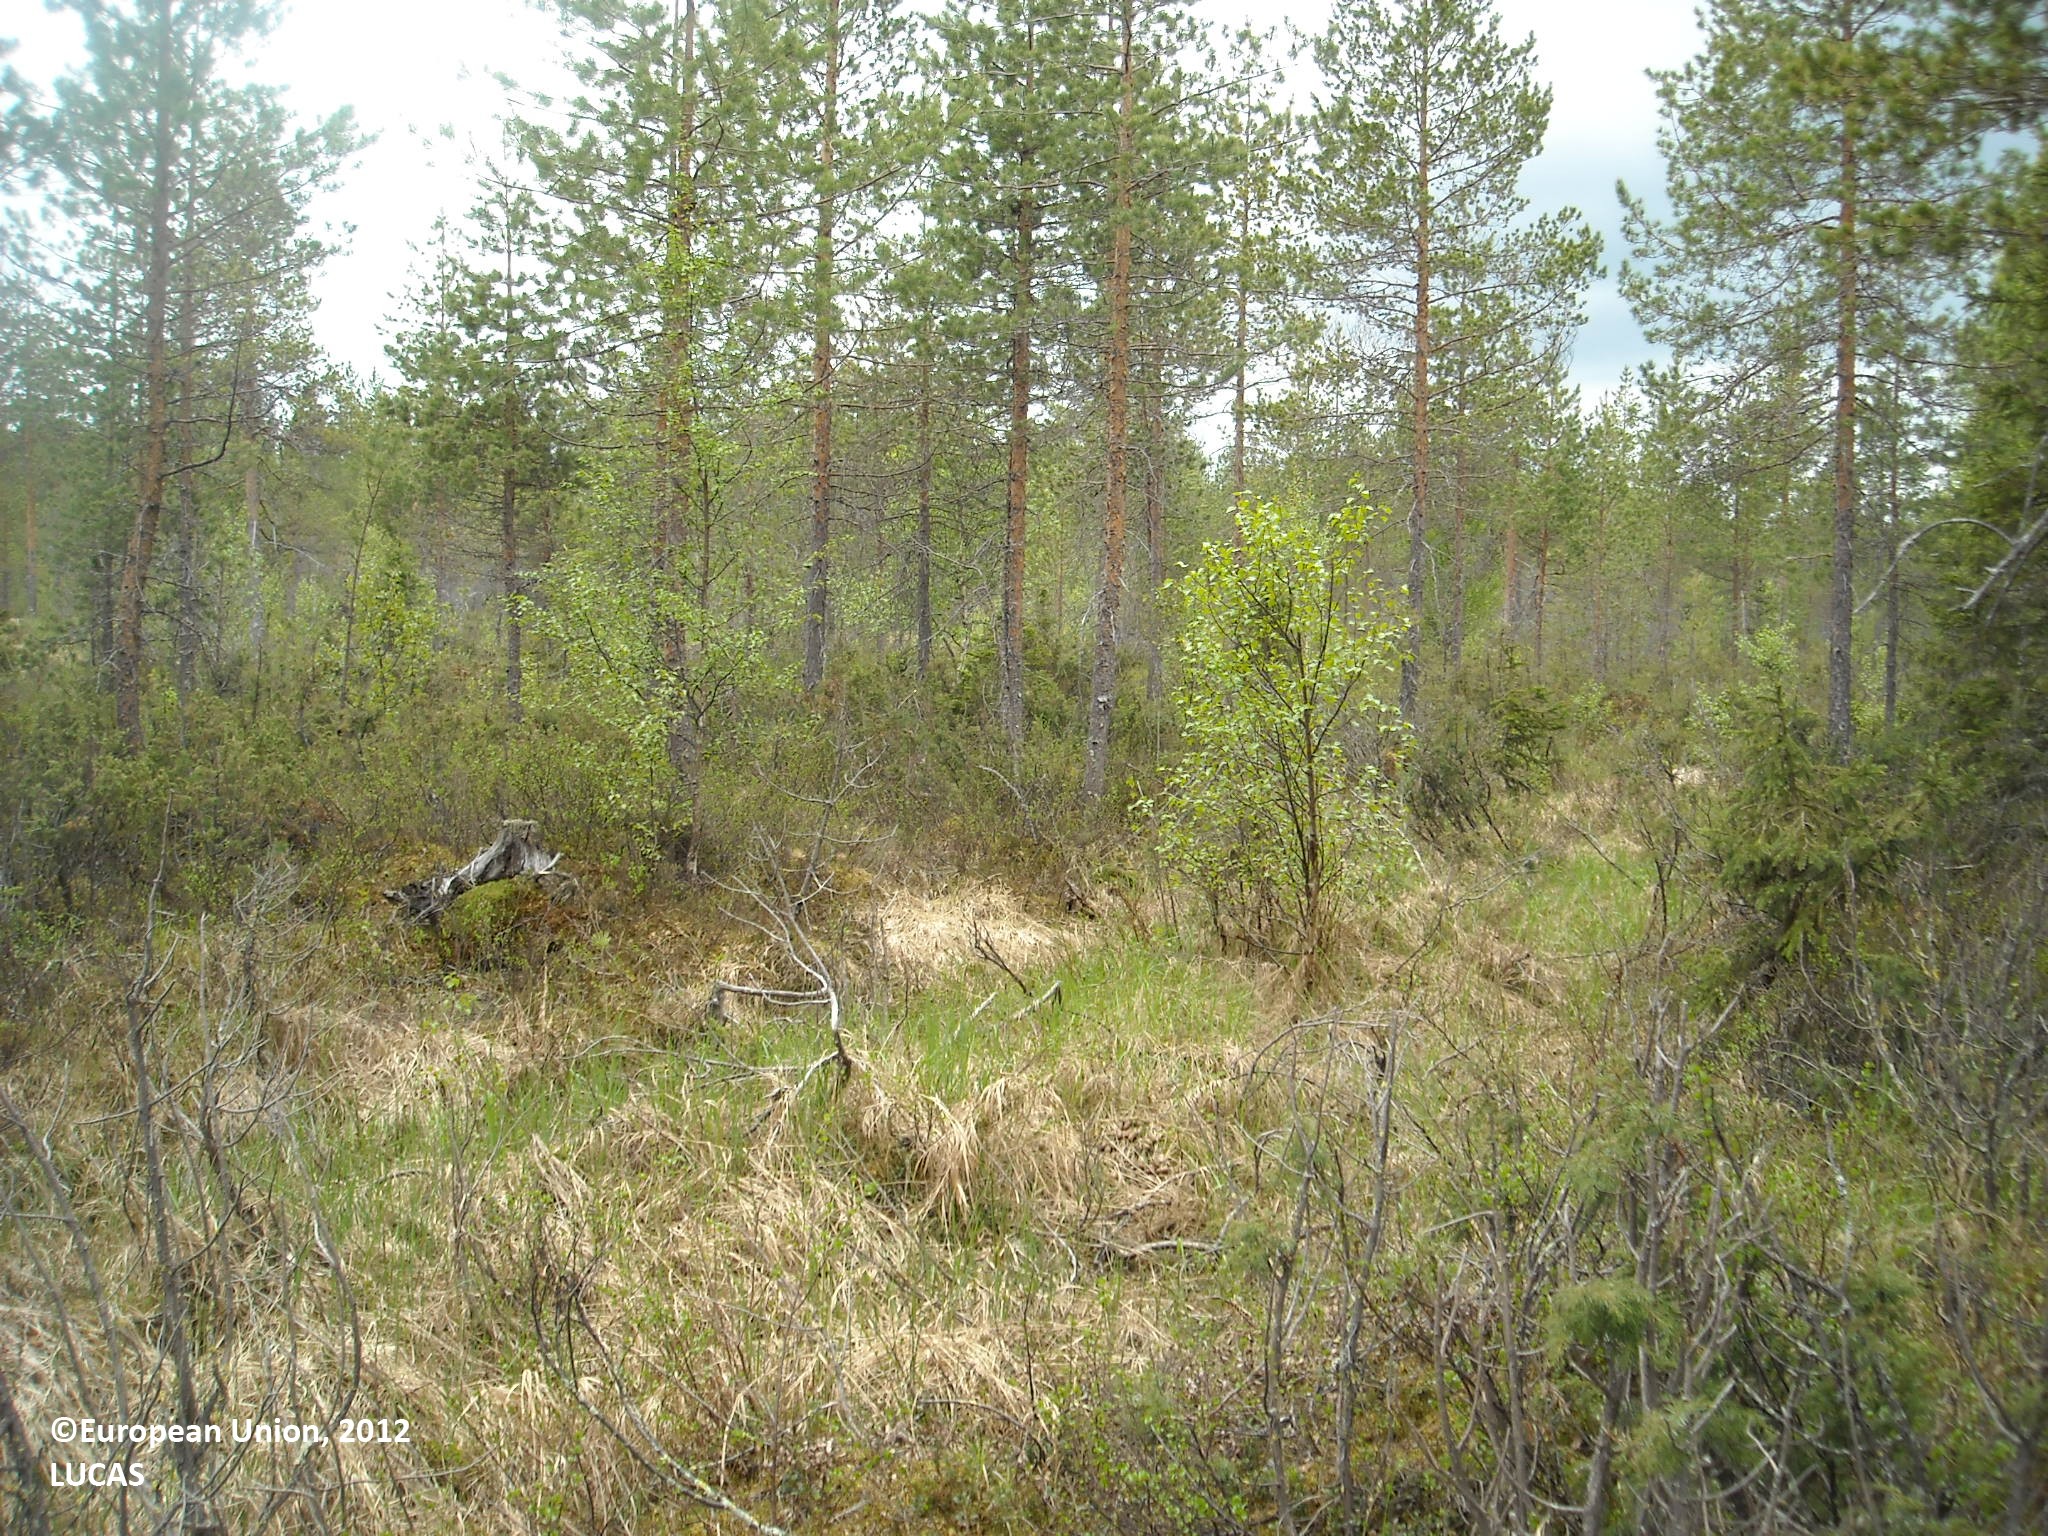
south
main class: Woodland
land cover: Pine dominated mixed woodland
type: mire and swamp forests
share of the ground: > 75 %
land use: Forestry
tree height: > 5 m
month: June
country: FI
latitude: 65.3294
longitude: 27.8566
